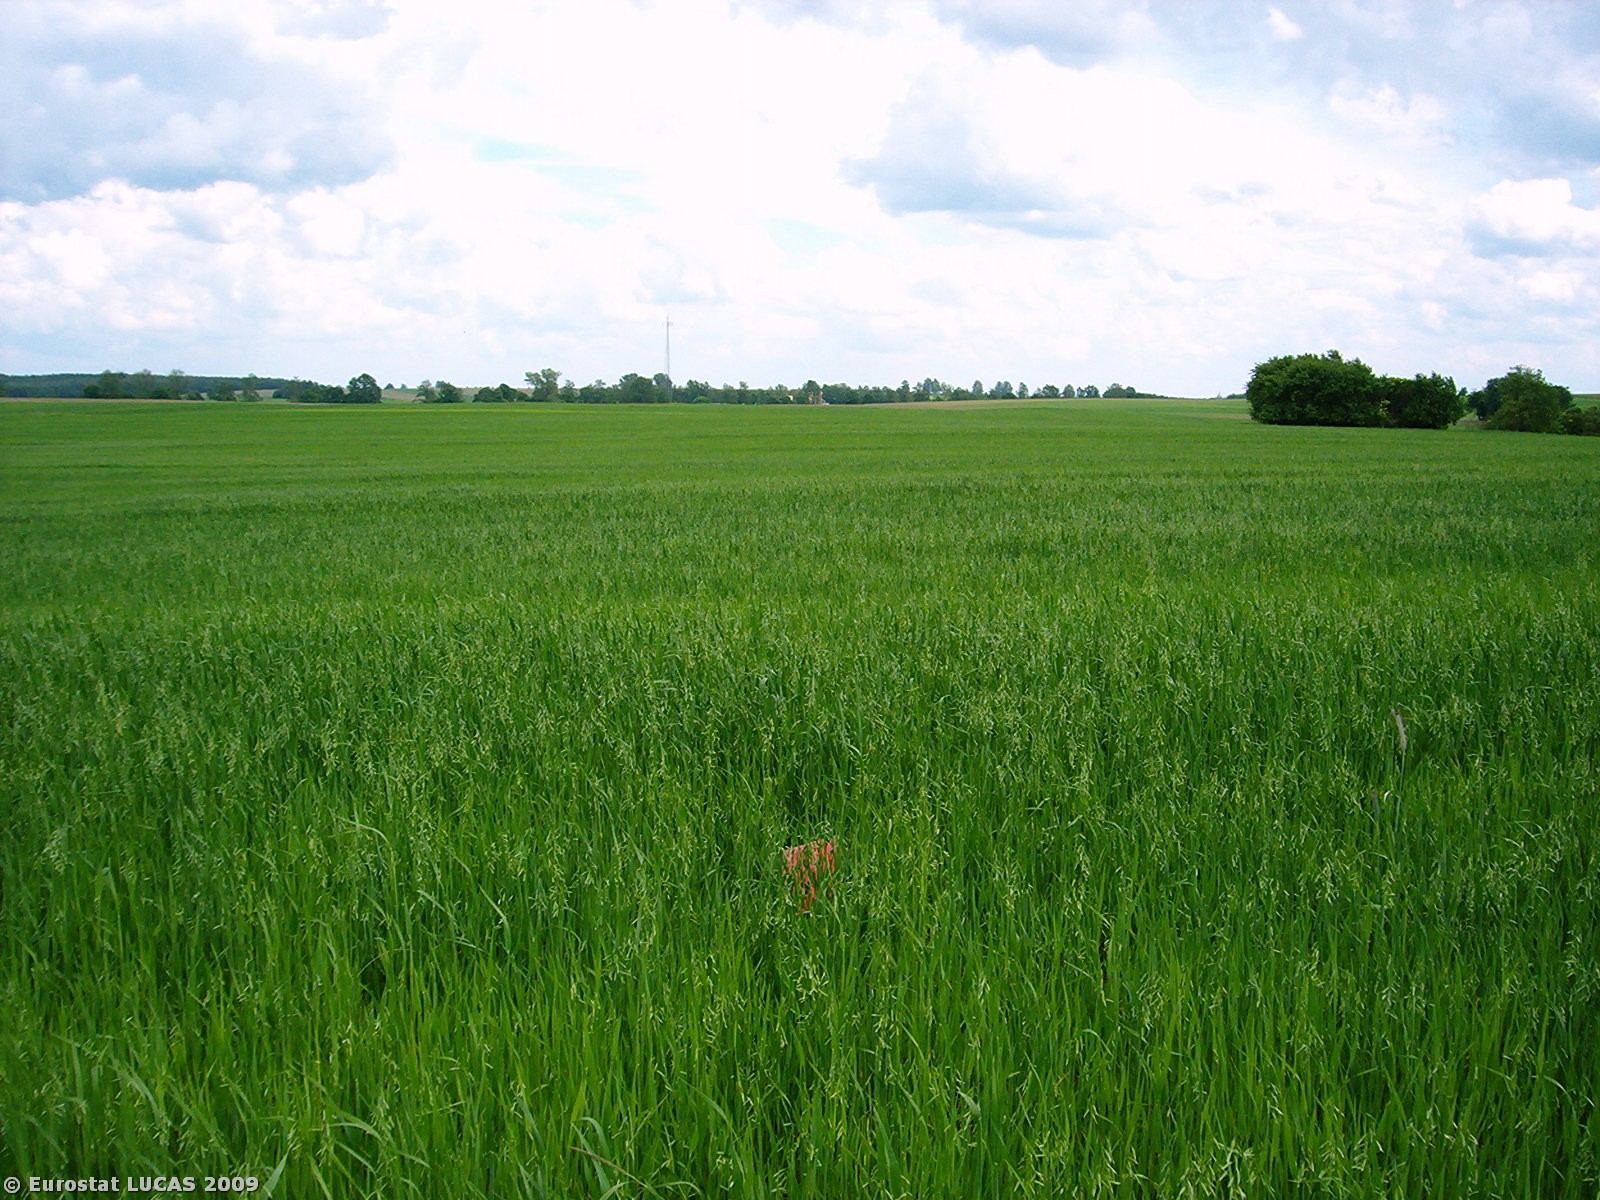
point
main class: Cropland
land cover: Oats
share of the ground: > 75 %
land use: Agriculture (excluding fallow land and kitchen gardens)
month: June
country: PL
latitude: 53.6230
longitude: 17.1612
